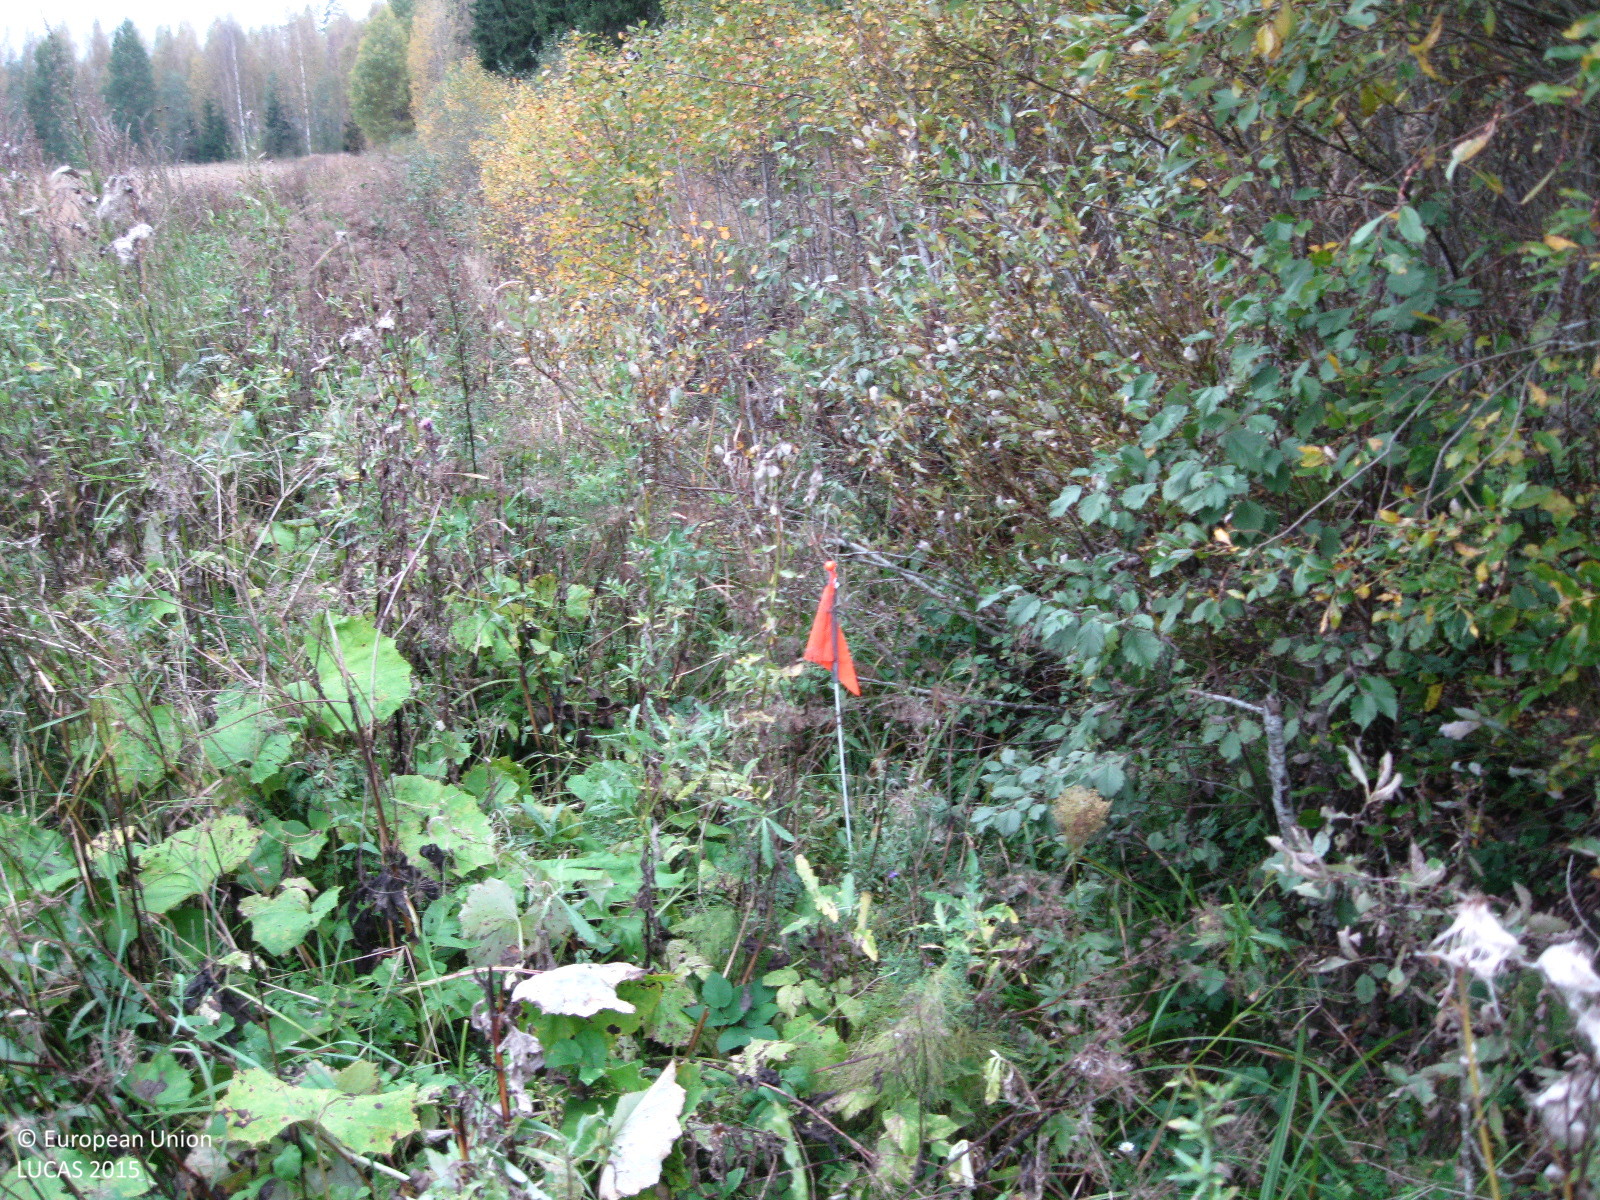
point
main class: Woodland
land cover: Broadleaved woodland
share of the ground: > 75 %
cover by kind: broadleaved forest trees 100 %
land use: Semi-natural and natural areas not in use
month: September
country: FI
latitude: 60.5981
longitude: 24.7002
